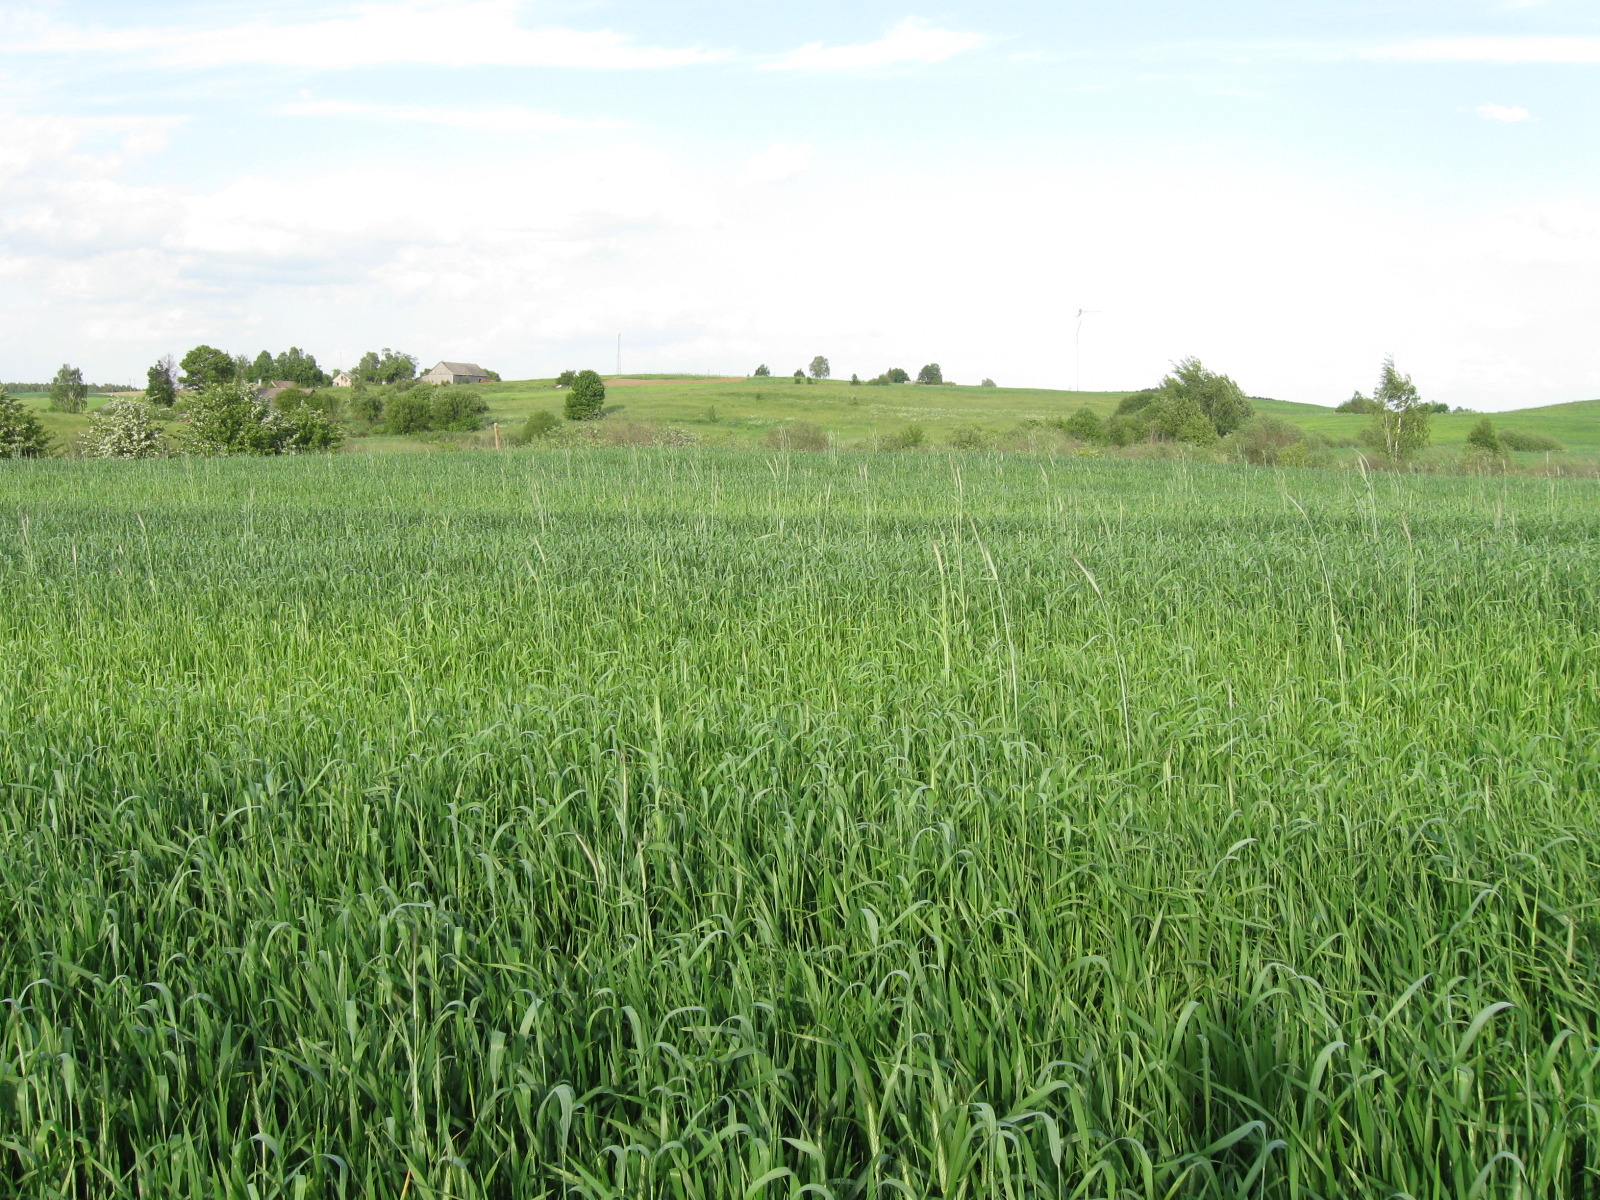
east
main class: Cropland
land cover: Common wheat
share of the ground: > 75 %
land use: Agriculture (excluding fallow land and kitchen gardens)
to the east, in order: Common wheat; Spontaneously vegetated surfaces; Broadleaved woodland; Inland marshes; Broadleaved woodland; Grassland without tree/shrub cover; Broadleaved woodland; Rivers and streams; Broadleaved woodland; Grassland without tree/shrub cover; Common wheat
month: June
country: LT
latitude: 54.2323
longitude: 23.6314
